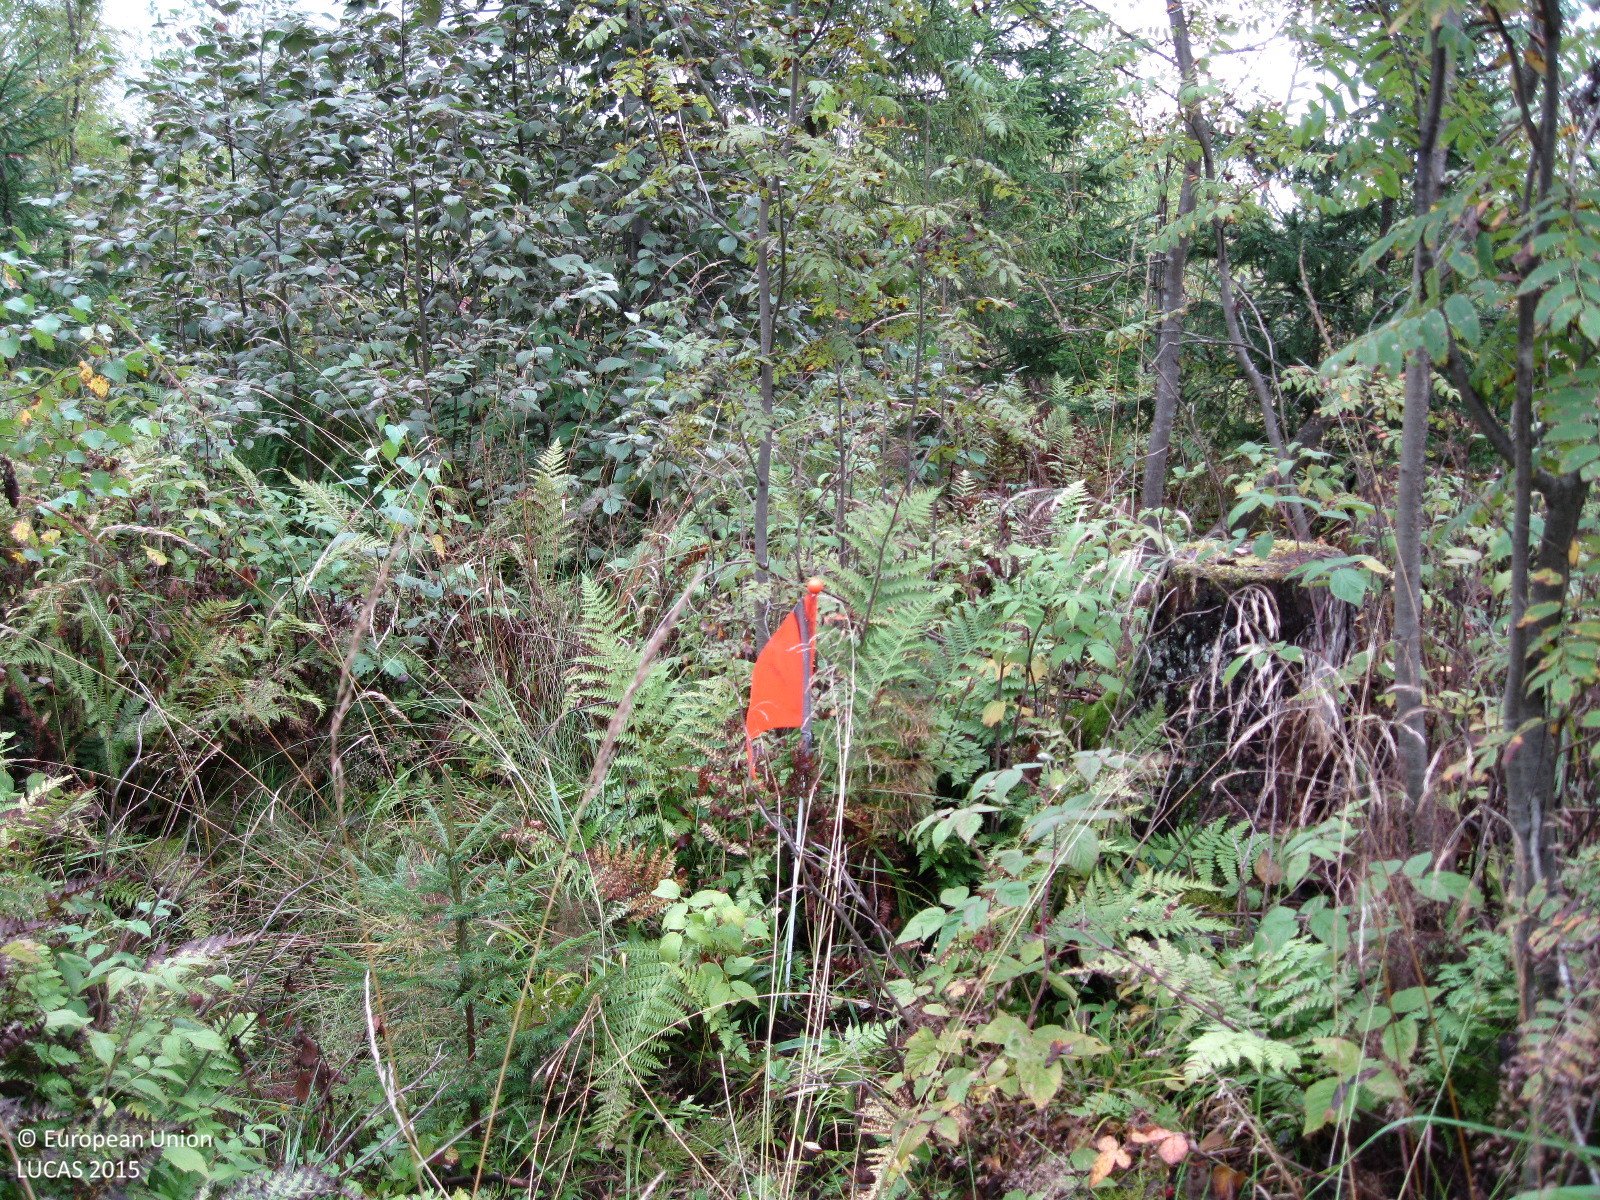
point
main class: Woodland
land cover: Broadleaved woodland
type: boreal forest
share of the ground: > 75 %
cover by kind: broadleaved forest trees 65 %, herbaceous plants 15 %, coniferous forest trees 10 %, shrubs 10 %
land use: Forestry
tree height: > 5 m
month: September
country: FI
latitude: 60.4816
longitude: 24.7592
